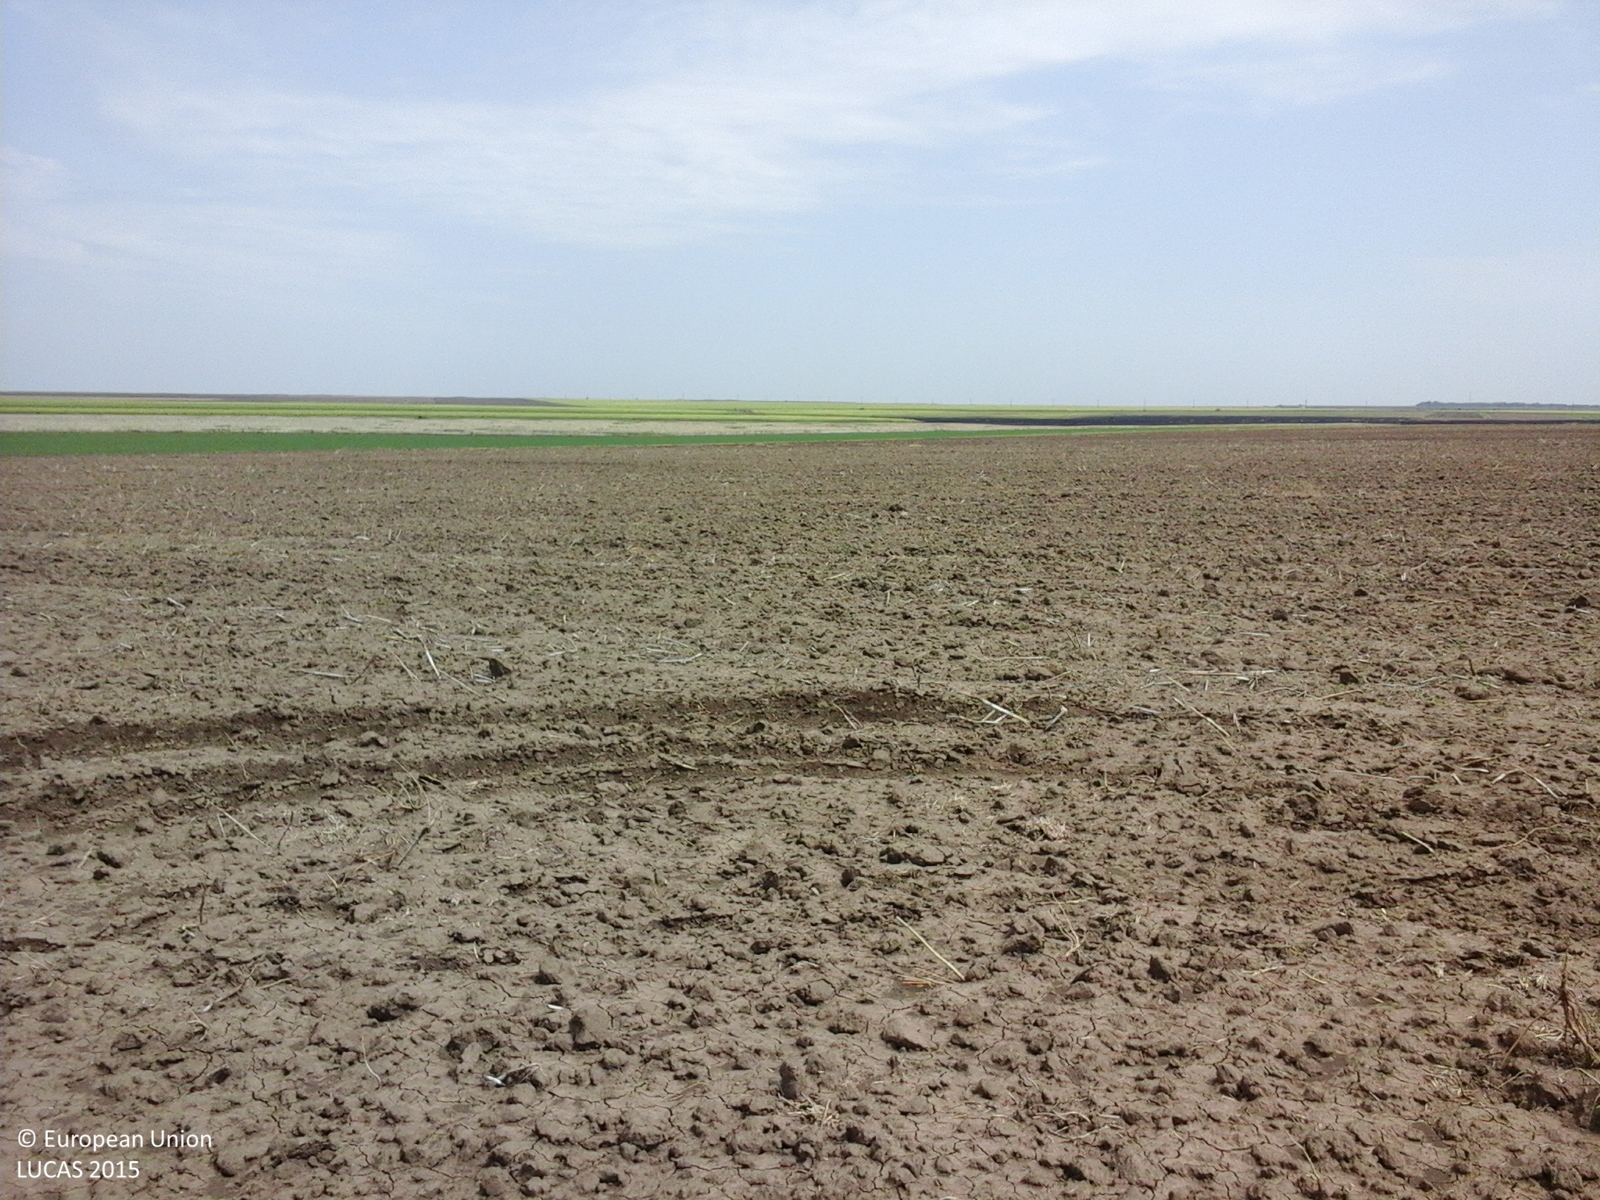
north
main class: Cropland
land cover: Rape and turnip rape
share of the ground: < 10 %
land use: Agriculture (excluding fallow land and kitchen gardens)
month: August
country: RO
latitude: 43.9796
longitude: 28.4028
